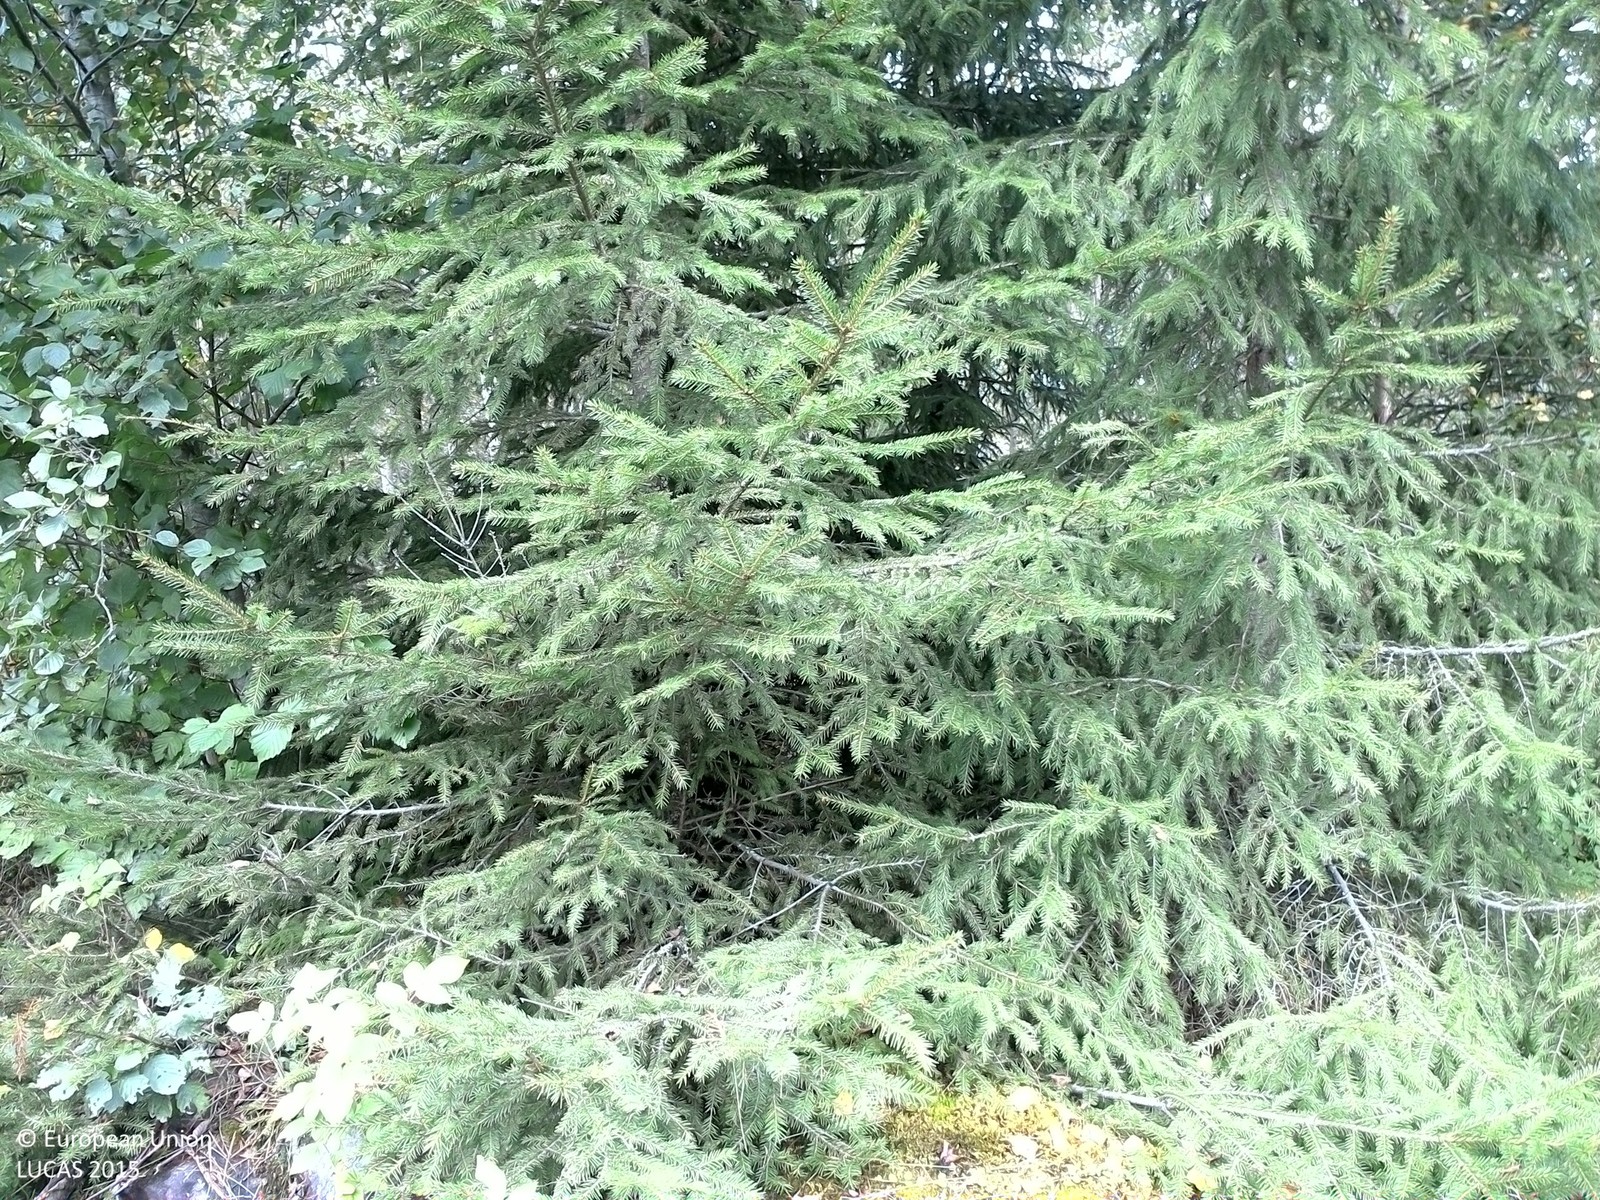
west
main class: Woodland
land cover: Spruce dominated mixed woodland
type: boreal forest
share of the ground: 25 - 50 %
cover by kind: coniferous forest trees 25 %, broadleaved forest trees 25 %, shrubs 20 %, herbaceous plants 15 %, lichens and mosses 15 %
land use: Forestry
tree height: > 5 m
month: September
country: SE
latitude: 59.9642
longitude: 13.1975
